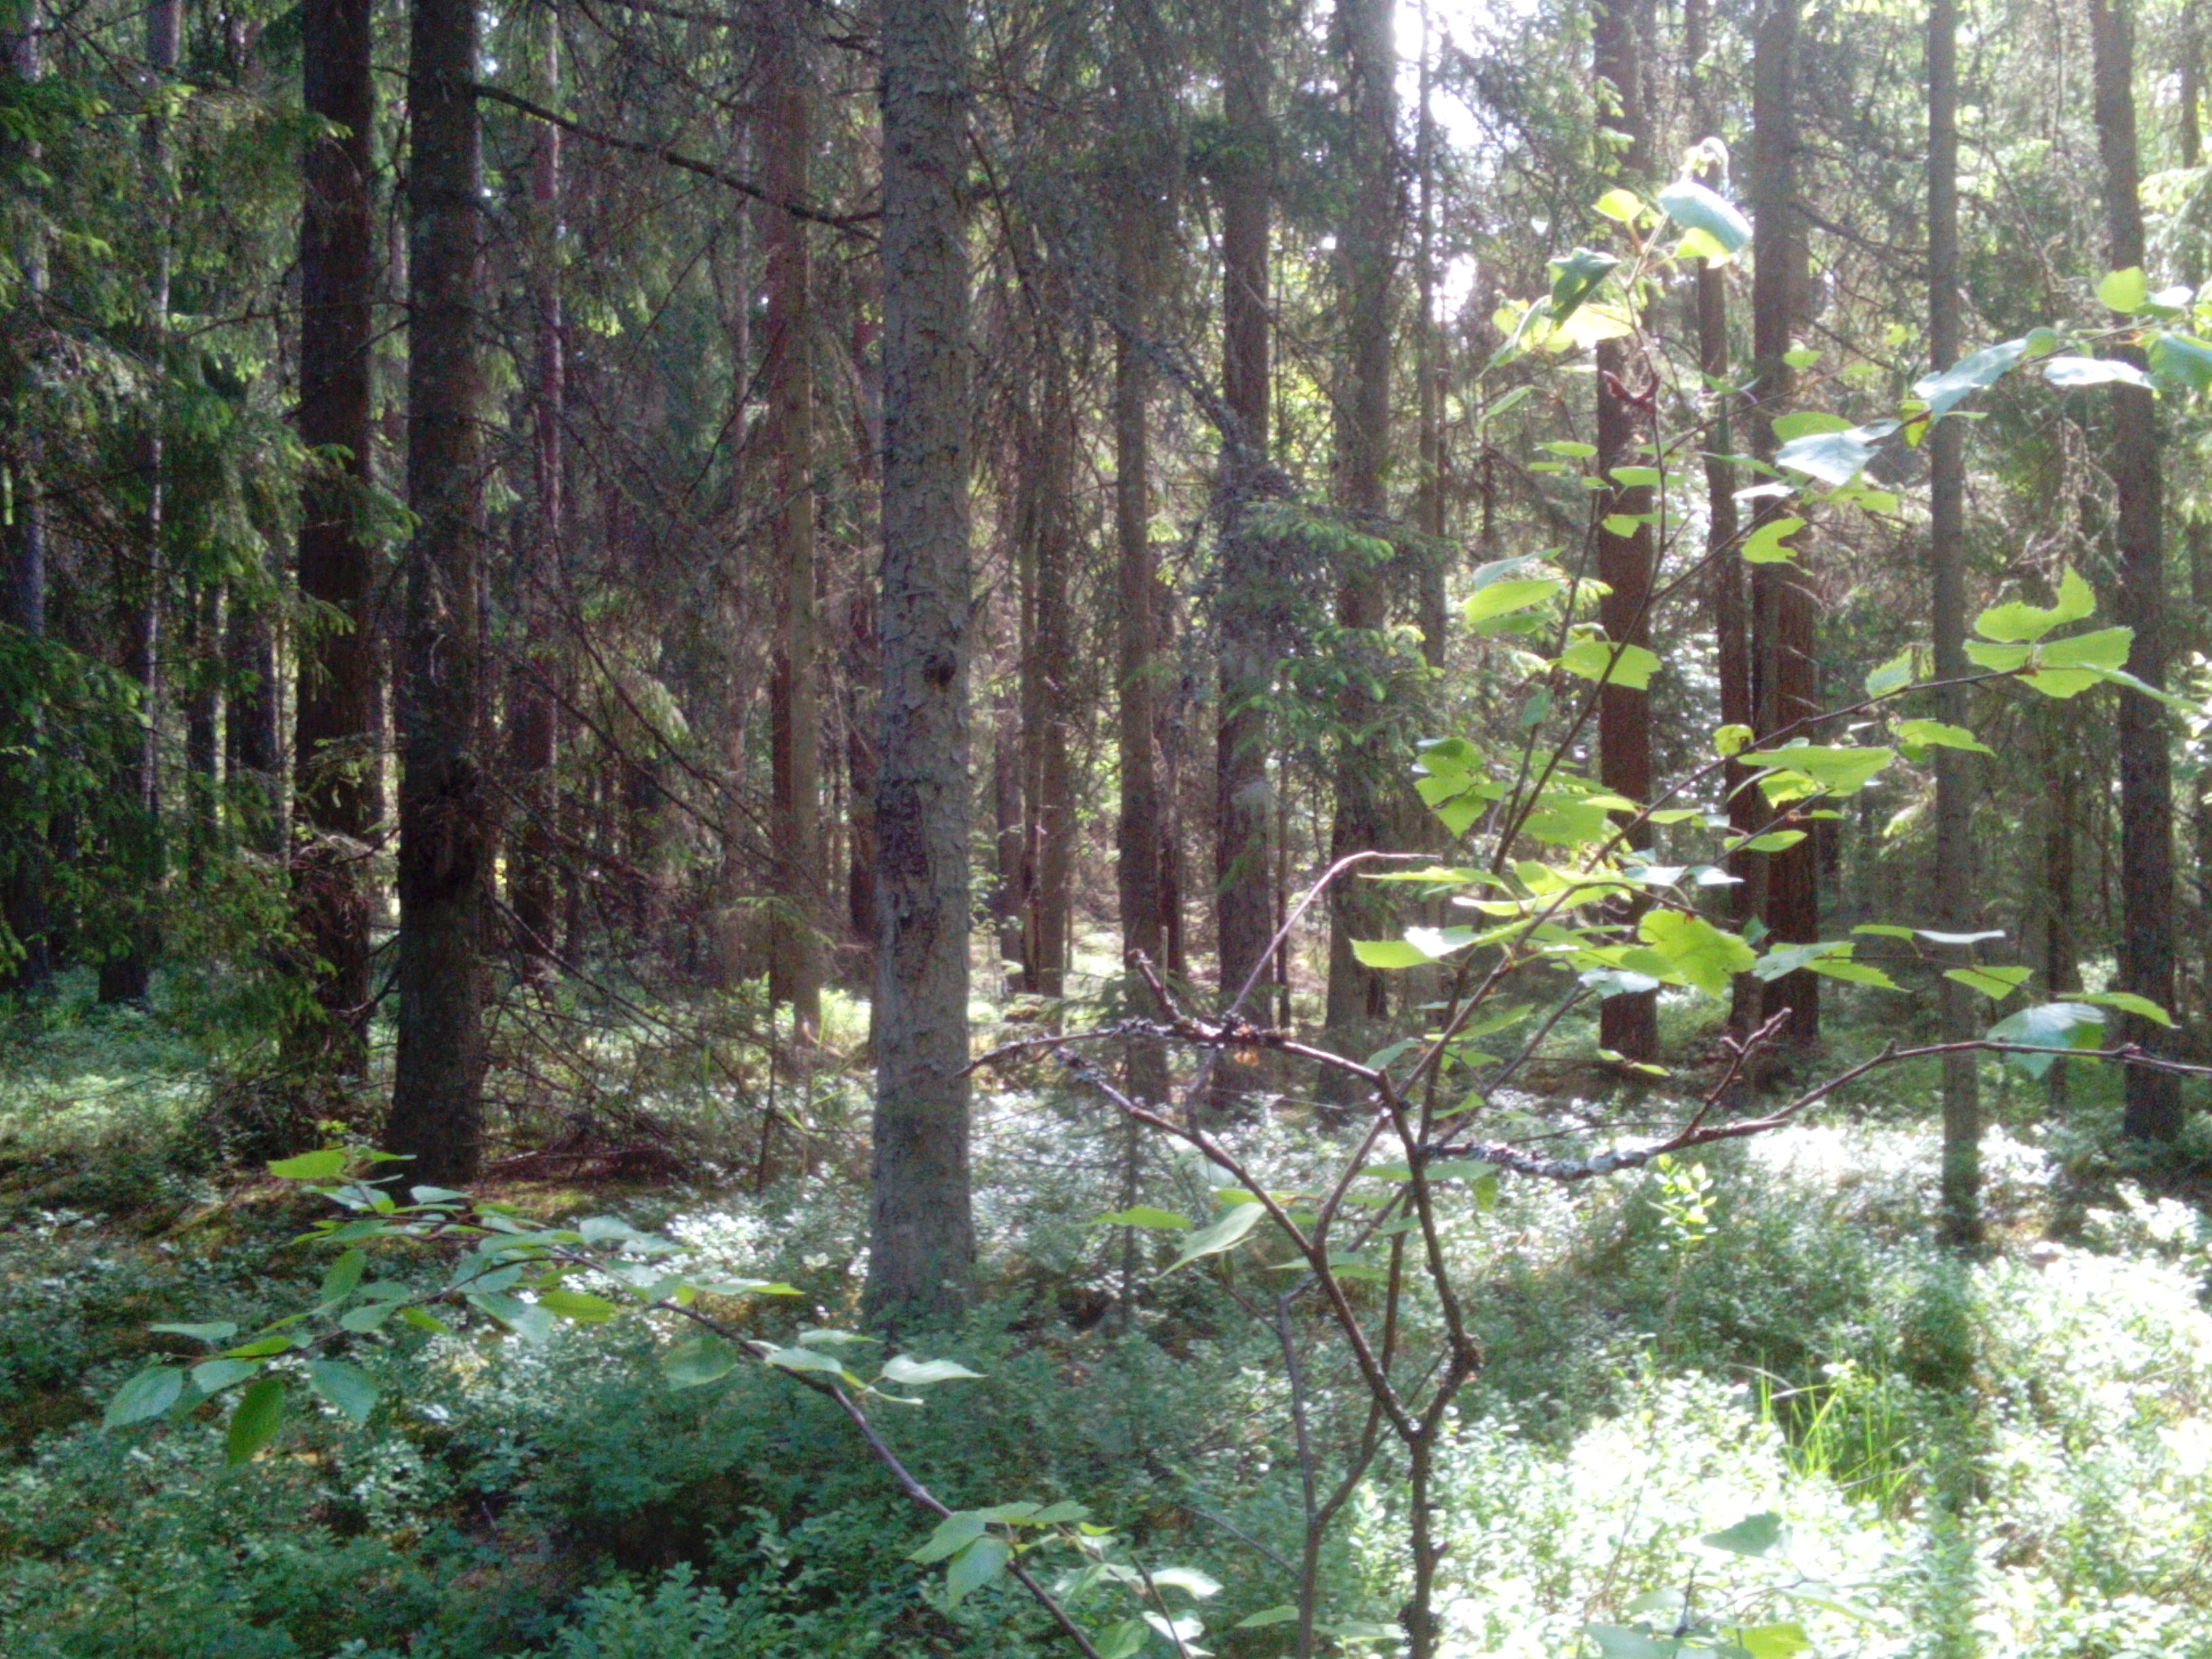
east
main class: Woodland
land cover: Other coniferous woodland
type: hemiboreal forest and nemoral coniferous forest and mixed broadleaved-coniferous forest
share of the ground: > 75 %
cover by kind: coniferous forest trees 75 %, herbaceous plants 10 %, lichens and mosses 10 %, broadleaved forest trees 5 %
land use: Forestry
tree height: > 5 m
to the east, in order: Other coniferous woodland
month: June
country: LV
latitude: 56.8506
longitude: 22.1013
